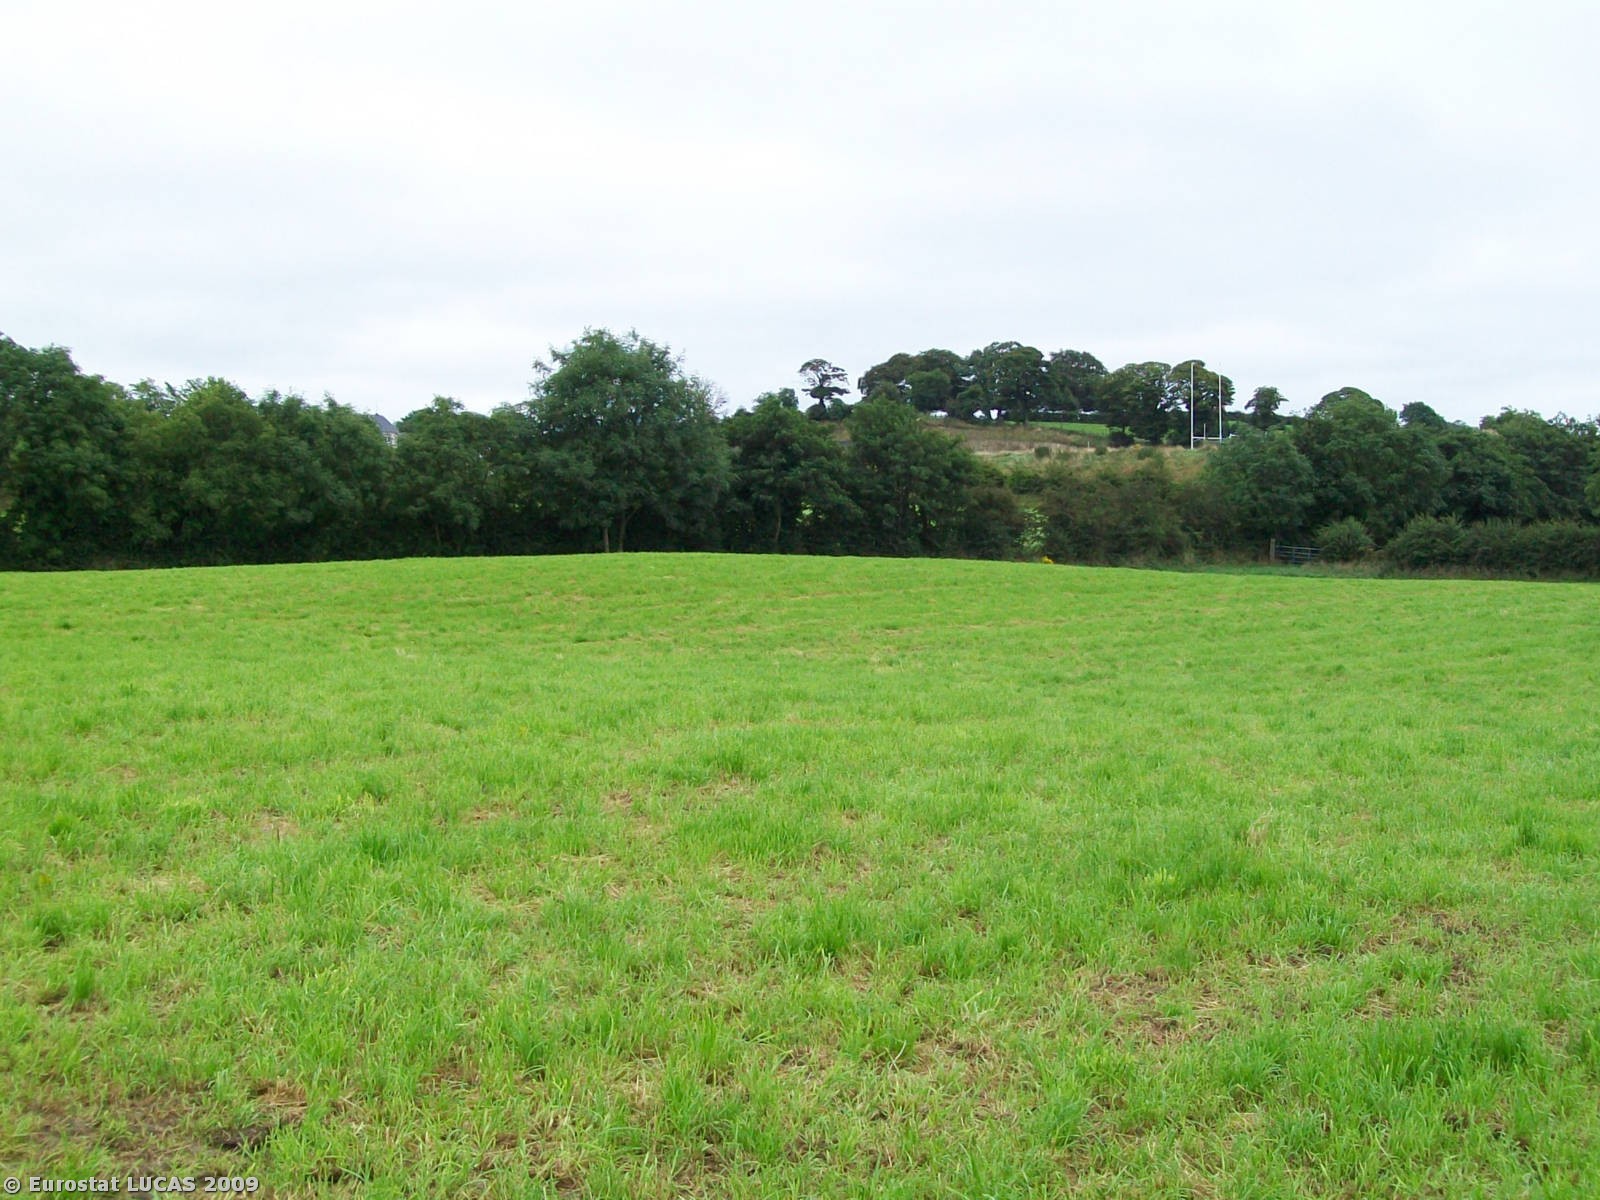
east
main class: Grassland
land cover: Grassland without tree/shrub cover
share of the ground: > 75 %
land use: Agriculture (excluding fallow land and kitchen gardens)
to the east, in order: Grassland without tree/shrub cover; Fences; Broadleaved woodland; Ditches and canals; Grassland without tree/shrub cover; Fences; Abandoned hedges; Grassland without tree/shrub cover
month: August
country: GB
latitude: 54.0585
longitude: -6.6443
